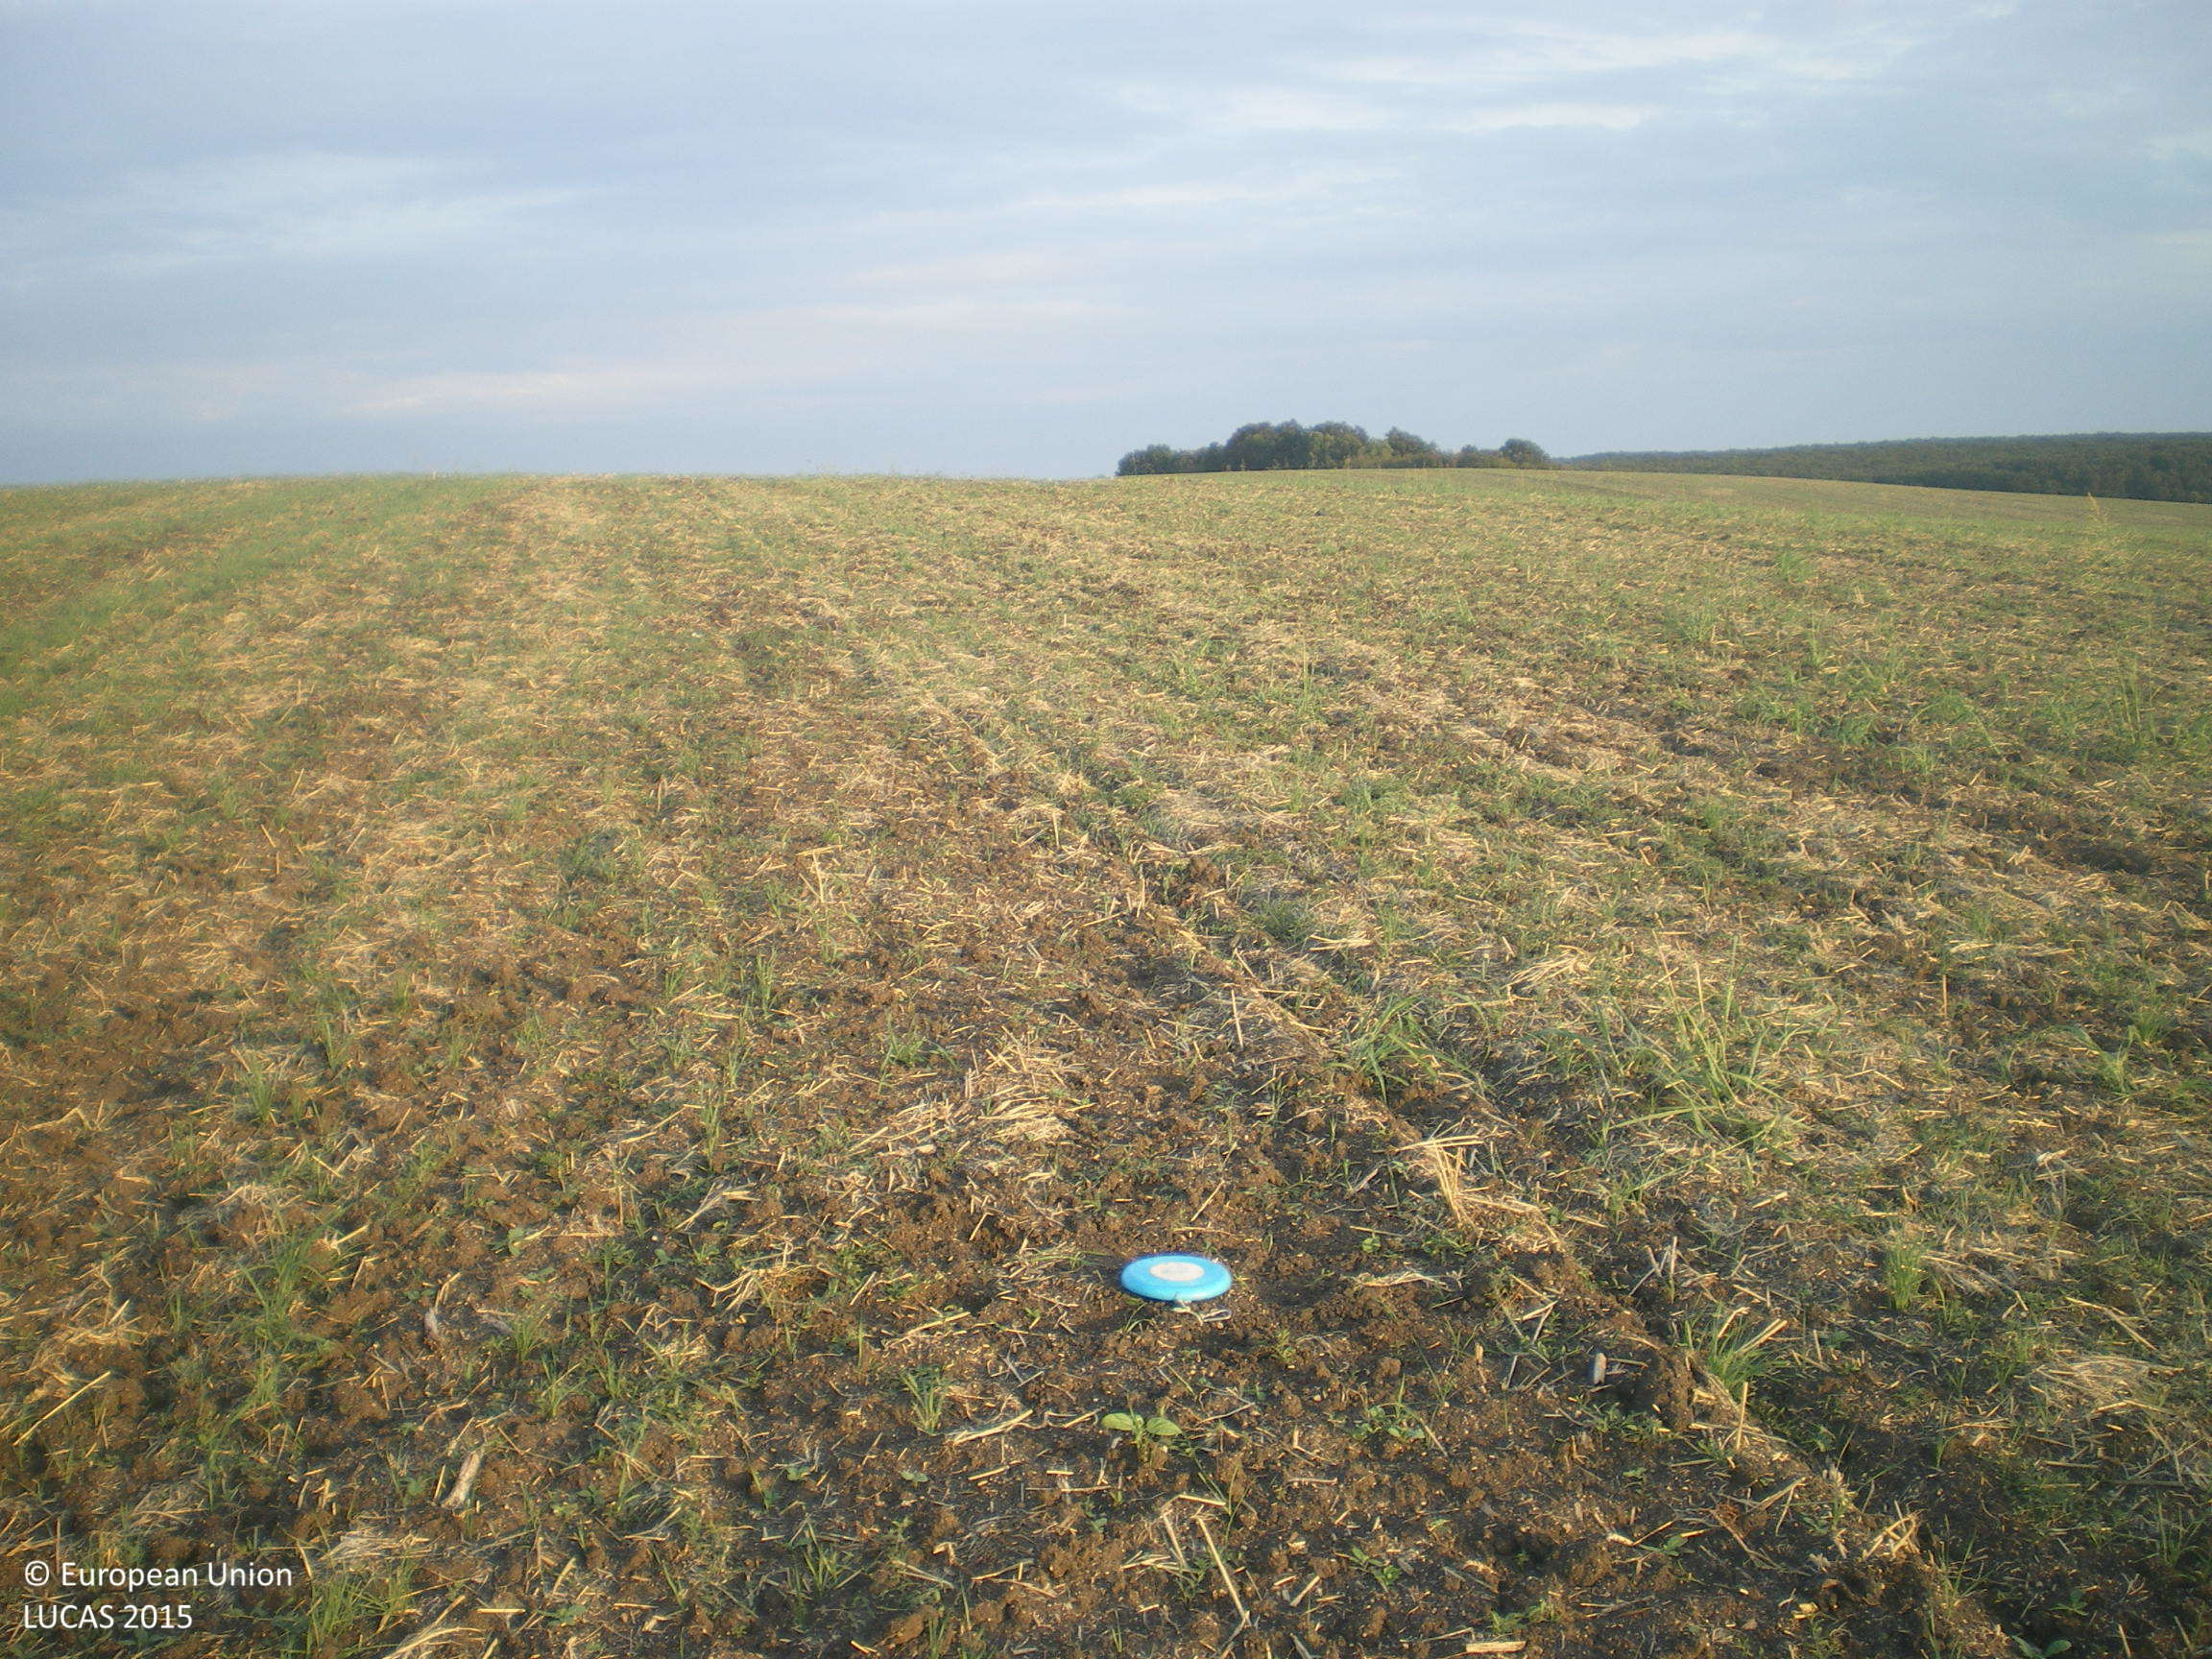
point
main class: Cropland
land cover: Common wheat
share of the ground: < 10 %
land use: Agriculture (excluding fallow land and kitchen gardens)
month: September
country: BG
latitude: 42.1588
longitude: 25.7938
